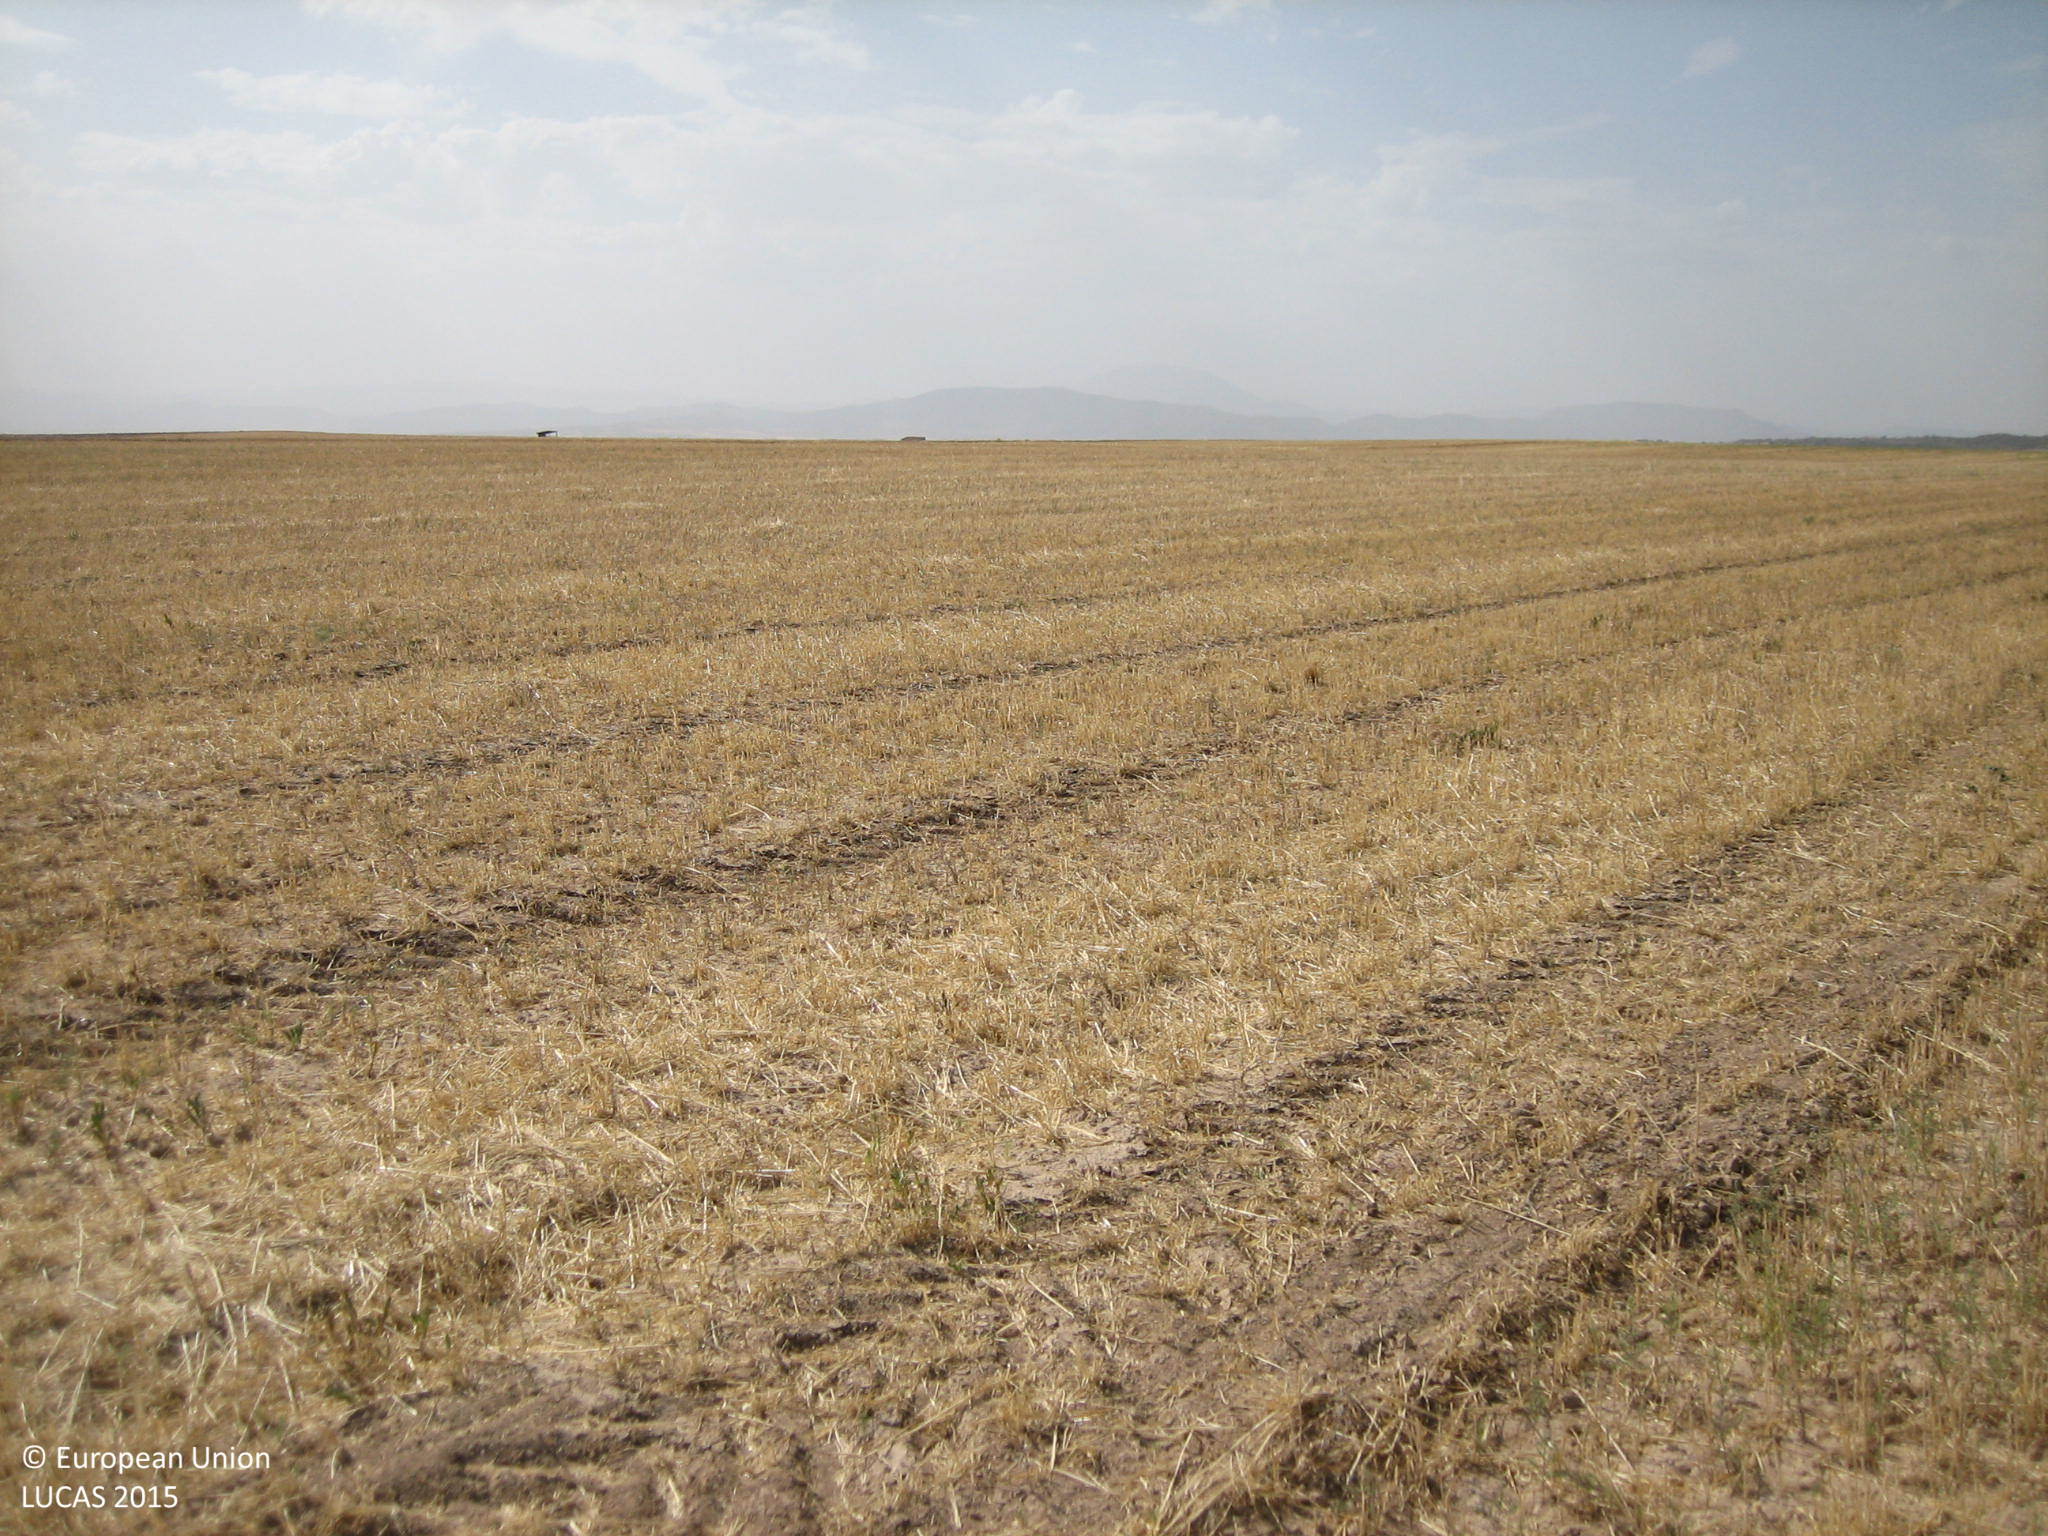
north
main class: Cropland
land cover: Barley
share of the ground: < 10 %
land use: Agriculture (excluding fallow land and kitchen gardens)
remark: Harvested field
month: July
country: ES
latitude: 37.7100
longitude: -2.3400
